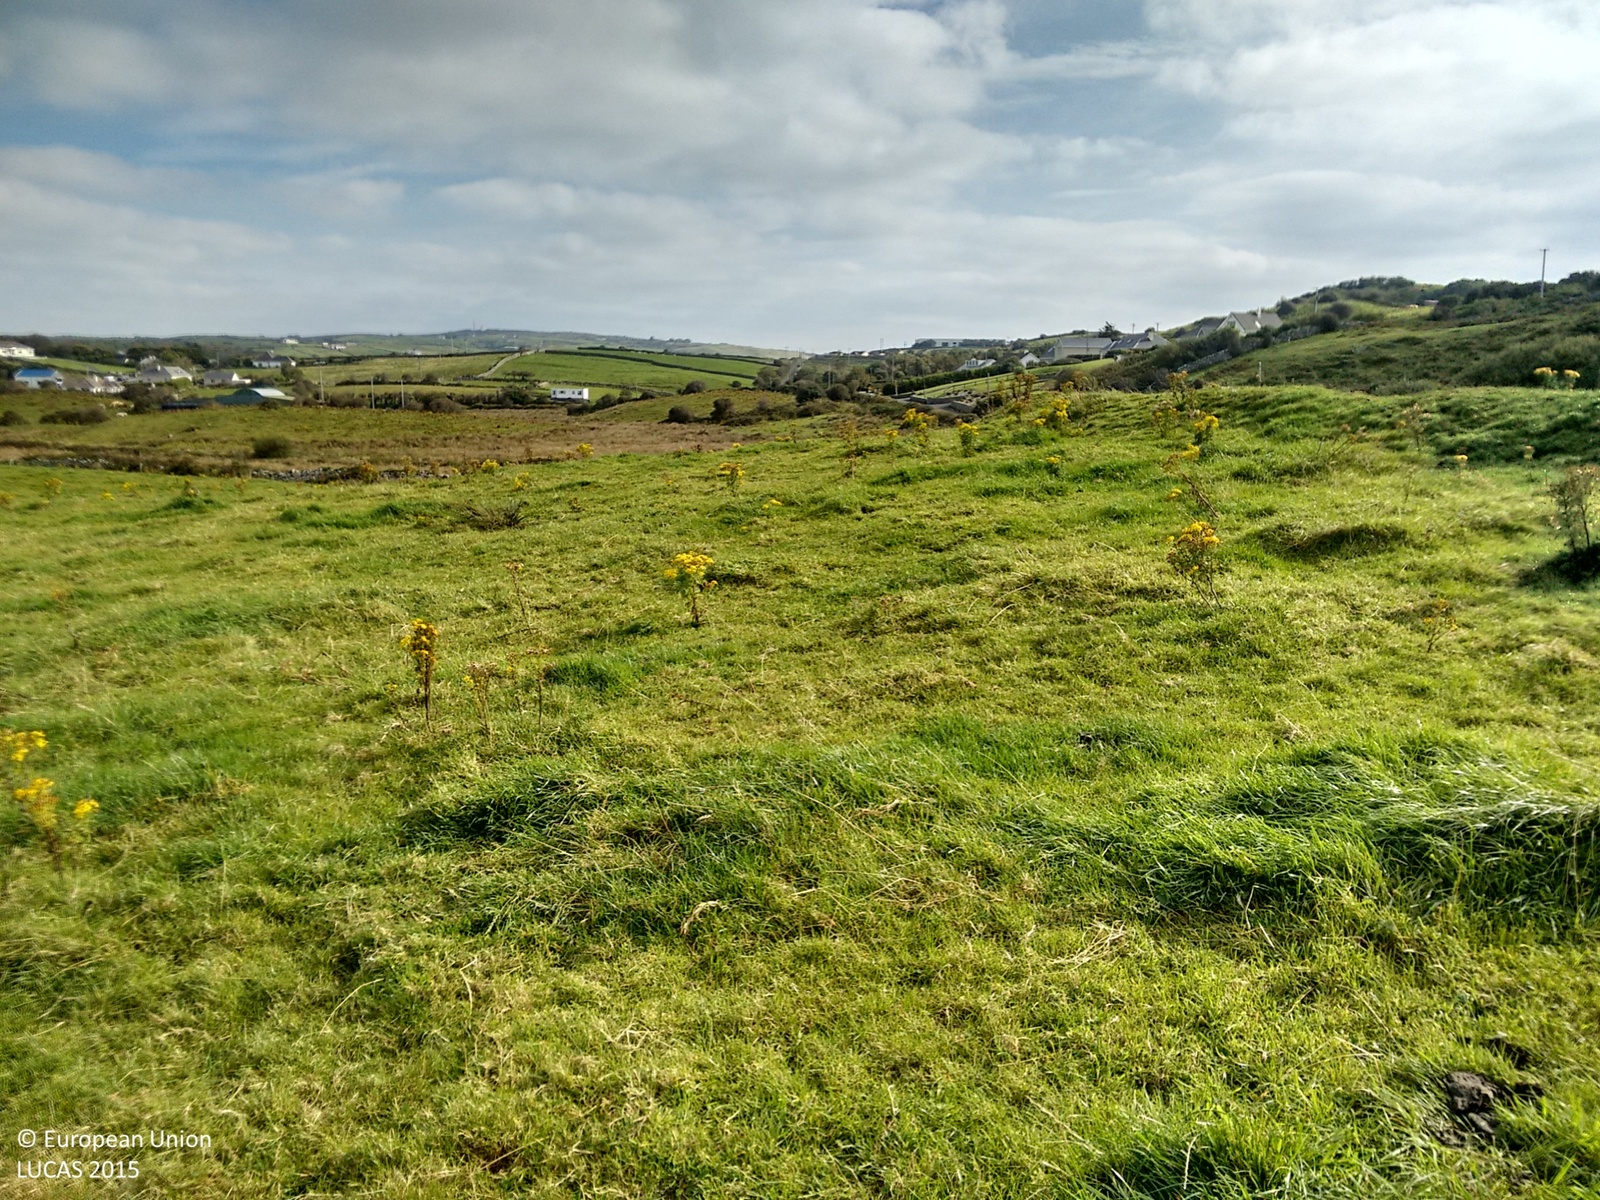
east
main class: Grassland
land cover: Grassland without tree/shrub cover
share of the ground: > 75 %
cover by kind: herbaceous plants 100 %
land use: Agriculture (excluding fallow land and kitchen gardens)
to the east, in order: Grassland without tree/shrub cover; Inland marshes; Fences; Dry stone walls; Grassland without tree/shrub cover; Fences; Ditches and canals; Abandoned hedges; Fences; Abandoned hedges; Grassland without tree/shrub cover; Shrubland with sparse tree cover; Managed hedges; Paved roads, cycling and walking lanes; Electric lines; Paved roads, cycling and walking lanes
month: September
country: IE
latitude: 52.9357
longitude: -9.3145
